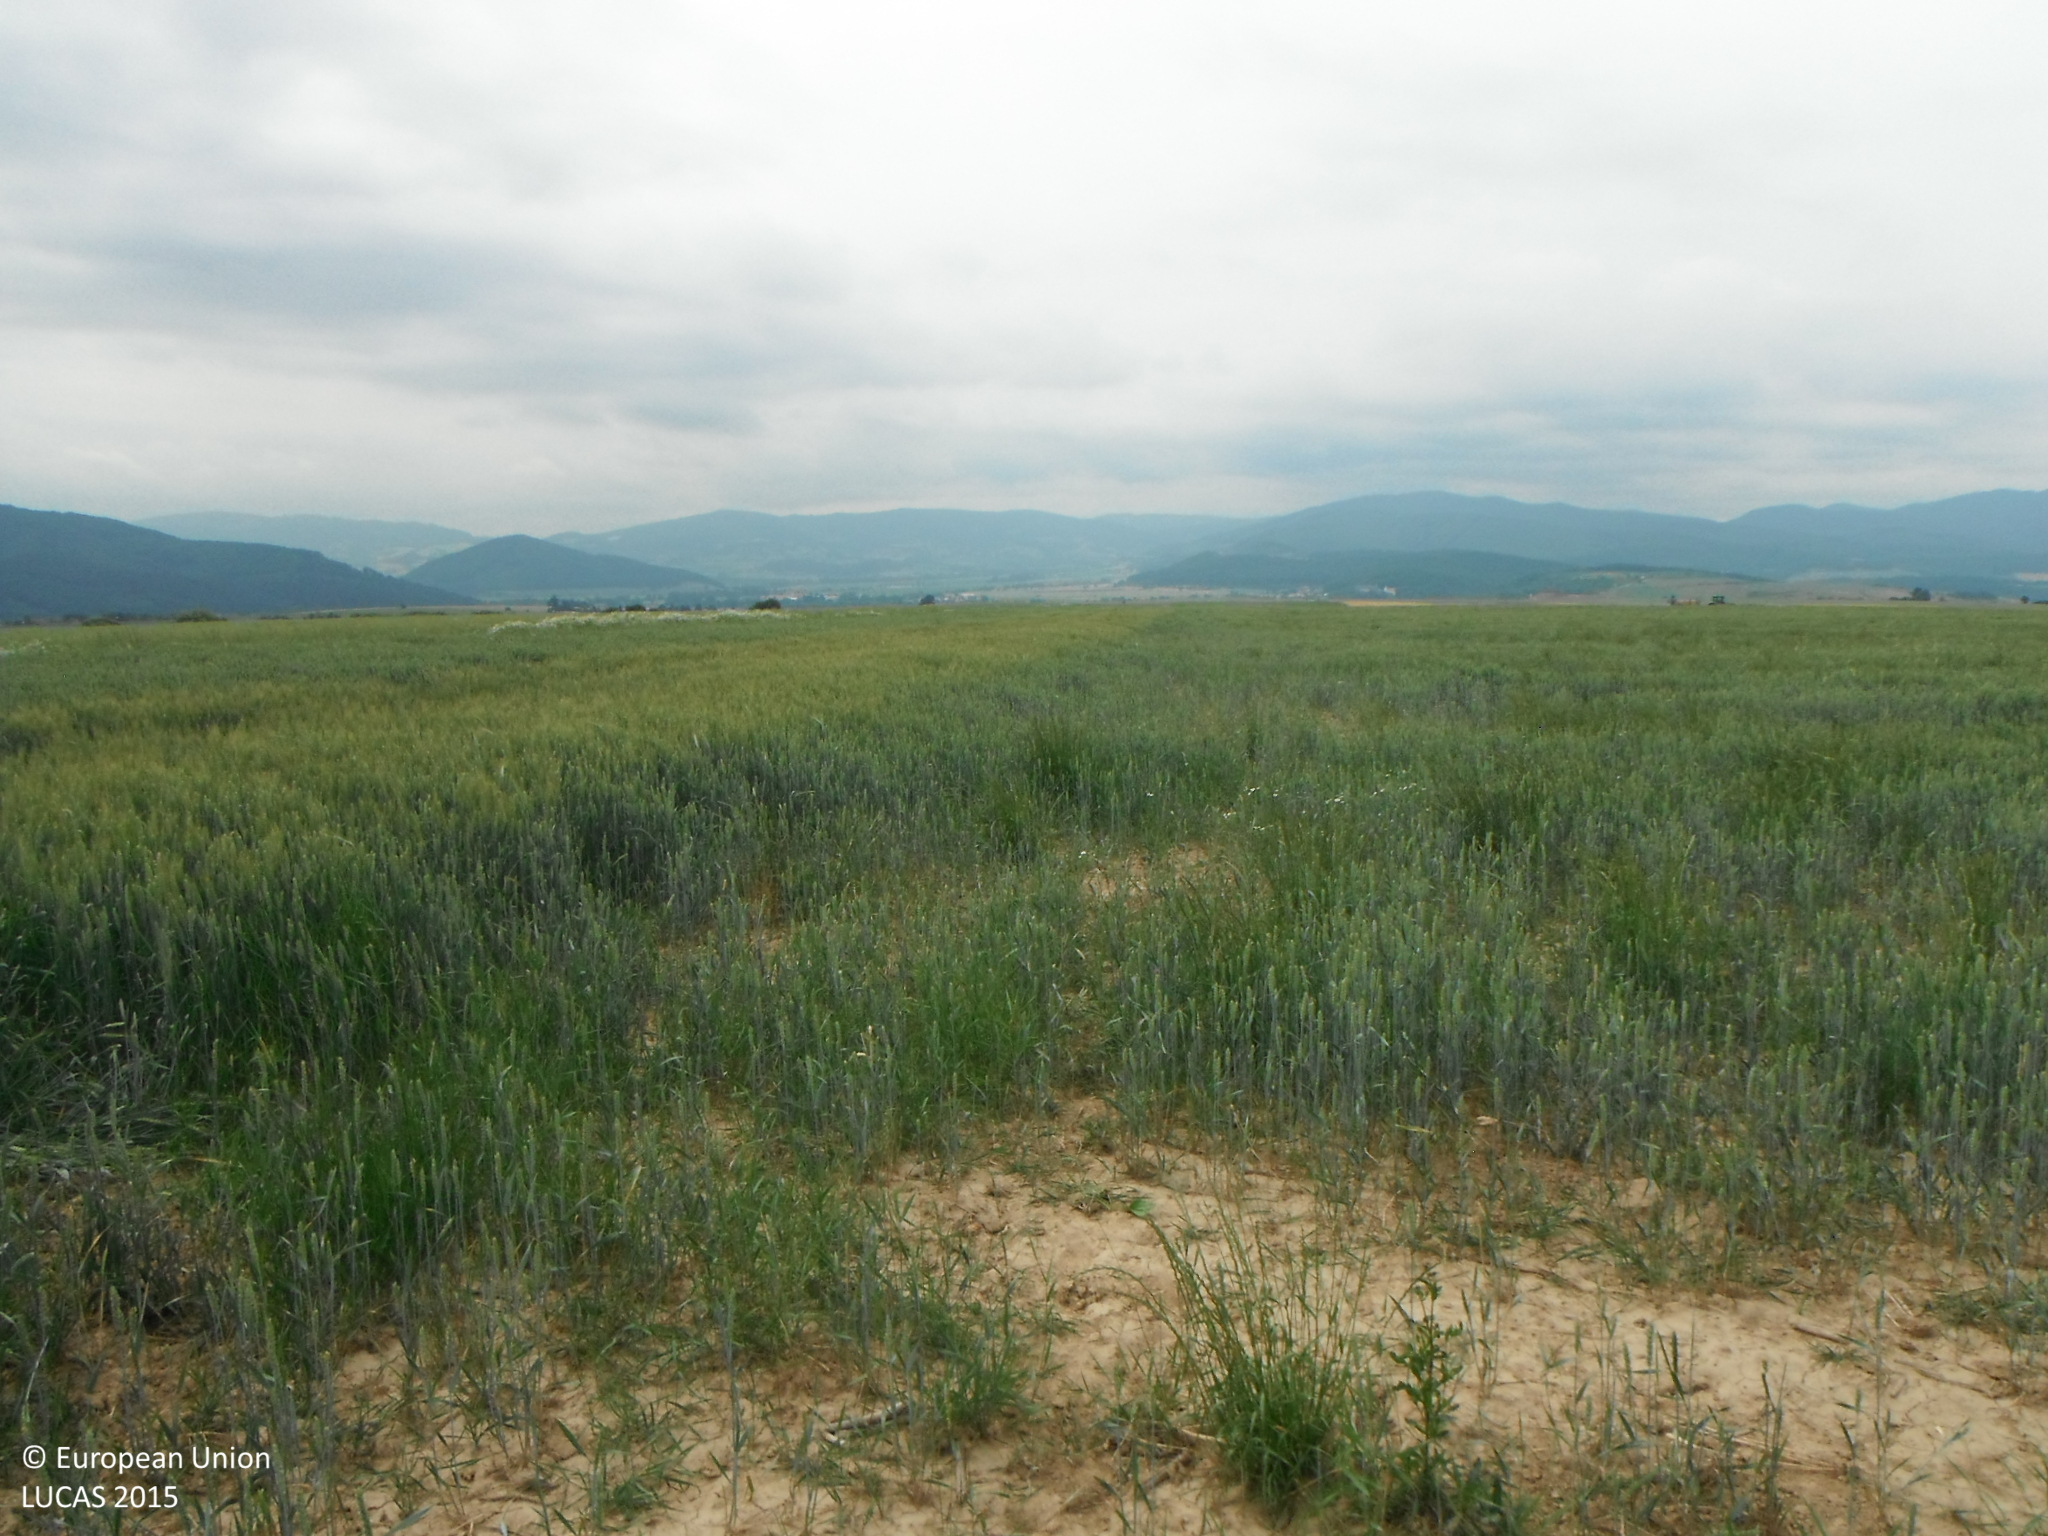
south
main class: Cropland
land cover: Common wheat
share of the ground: > 75 %
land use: Agriculture (excluding fallow land and kitchen gardens)
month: June
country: SK
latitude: 48.5894
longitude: 19.3103
